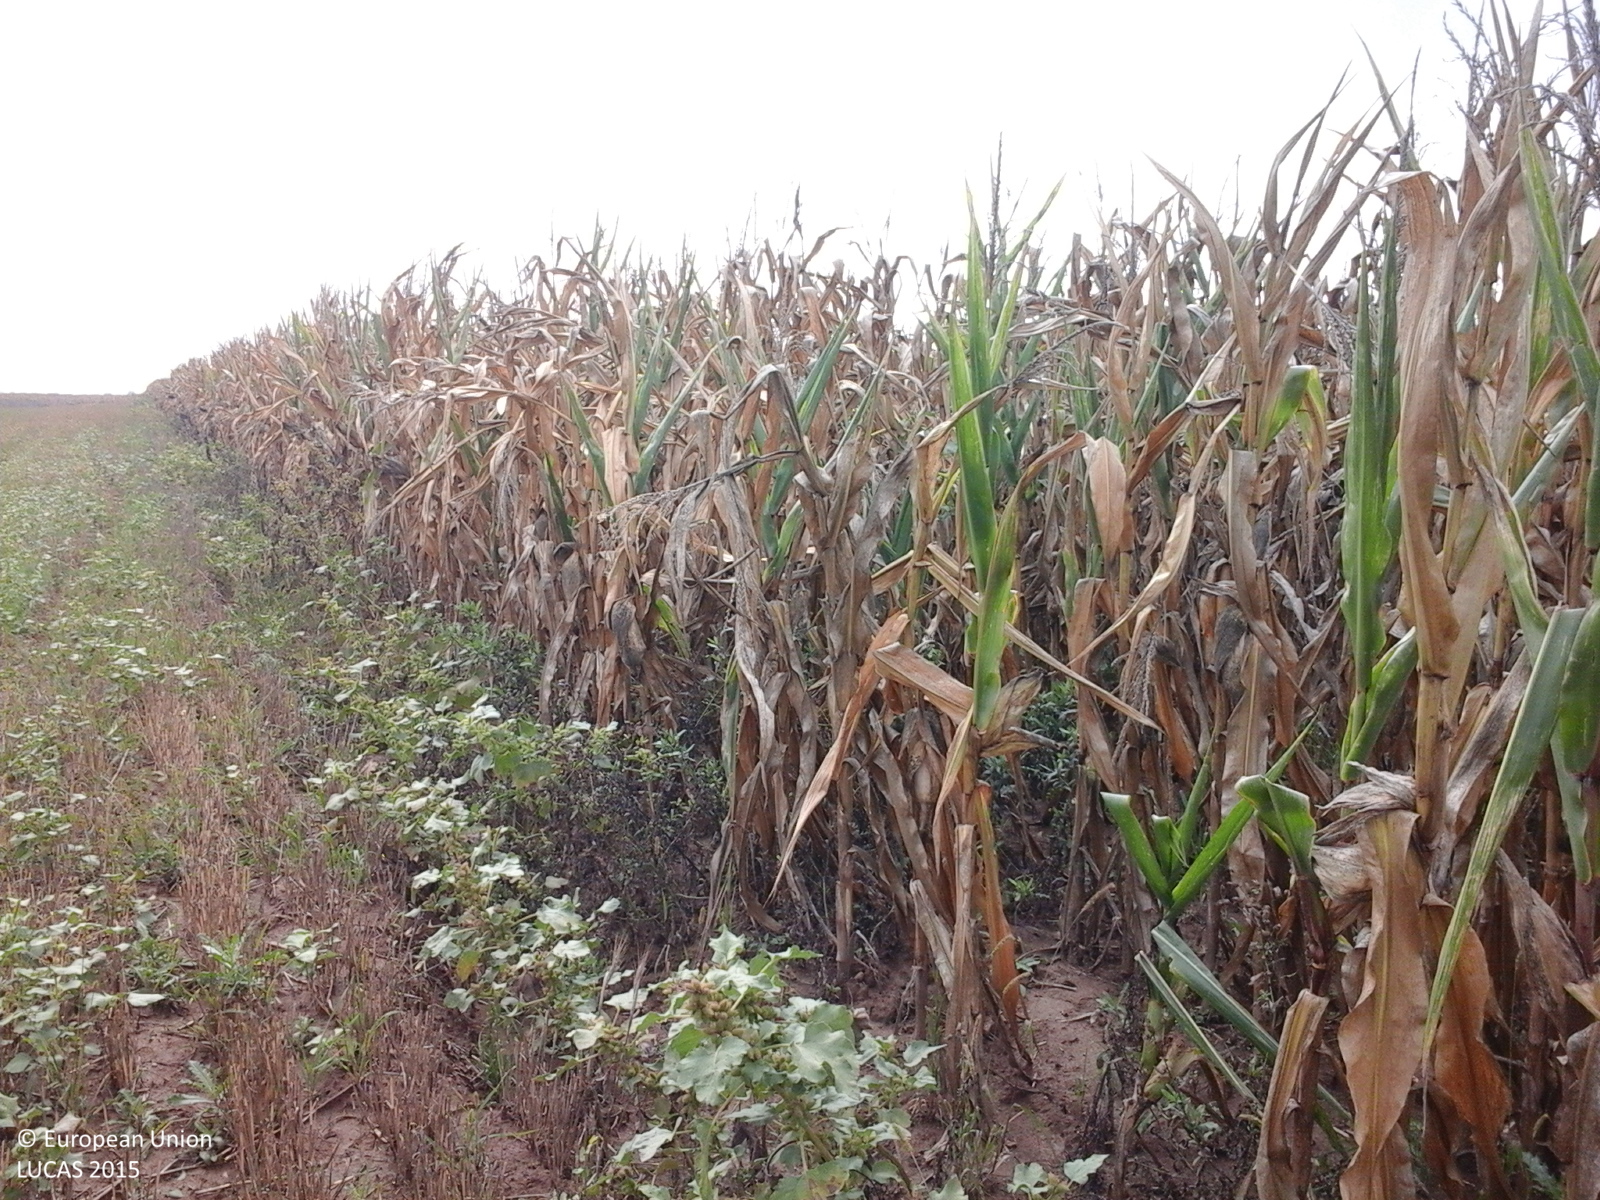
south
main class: Cropland
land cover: Maize
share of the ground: > 75 %
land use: Agriculture (excluding fallow land and kitchen gardens)
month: September
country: RO
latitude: 46.7317
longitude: 21.8072
